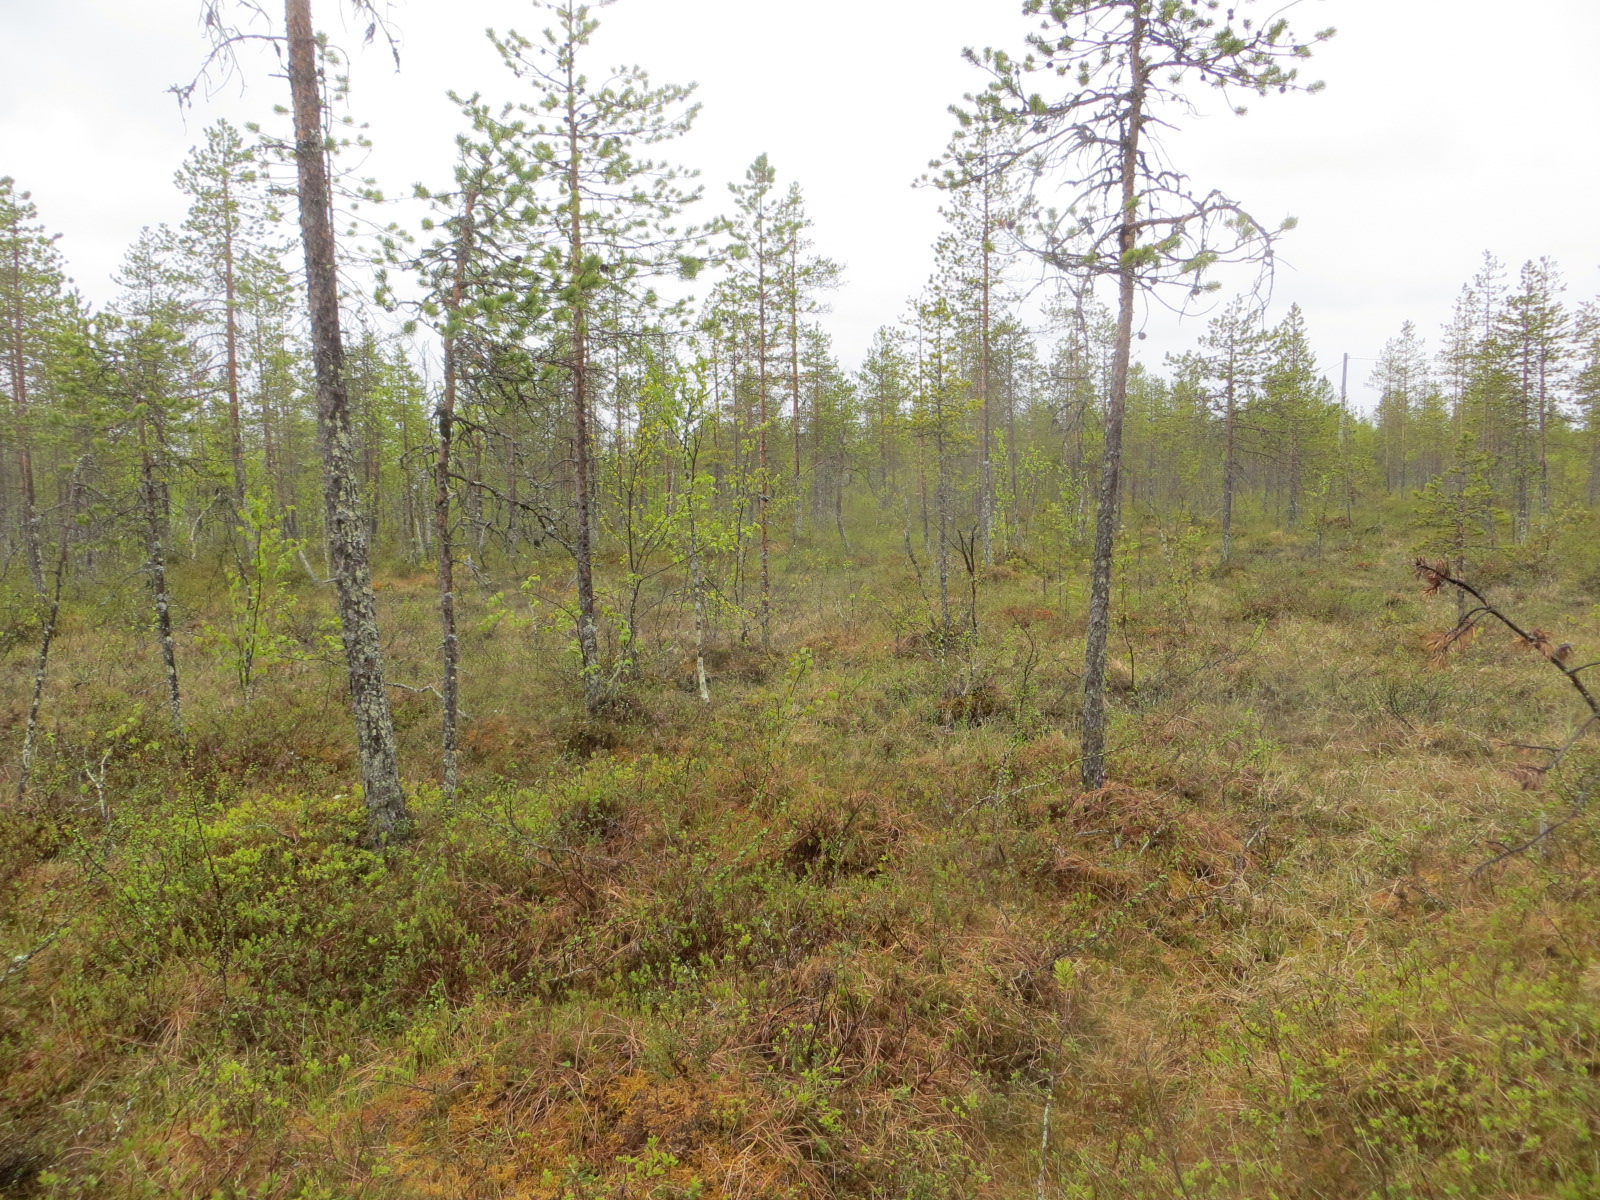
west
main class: Woodland
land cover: Other mixed woodland
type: boreal forest
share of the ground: > 75 %
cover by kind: coniferous forest trees 50 %, broadleaved forest trees 25 %, shrubs 10 %, herbaceous plants 10 %, lichens and mosses 5 %
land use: Forestry
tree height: > 5 m
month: June
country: FI
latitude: 67.2546
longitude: 25.5596
